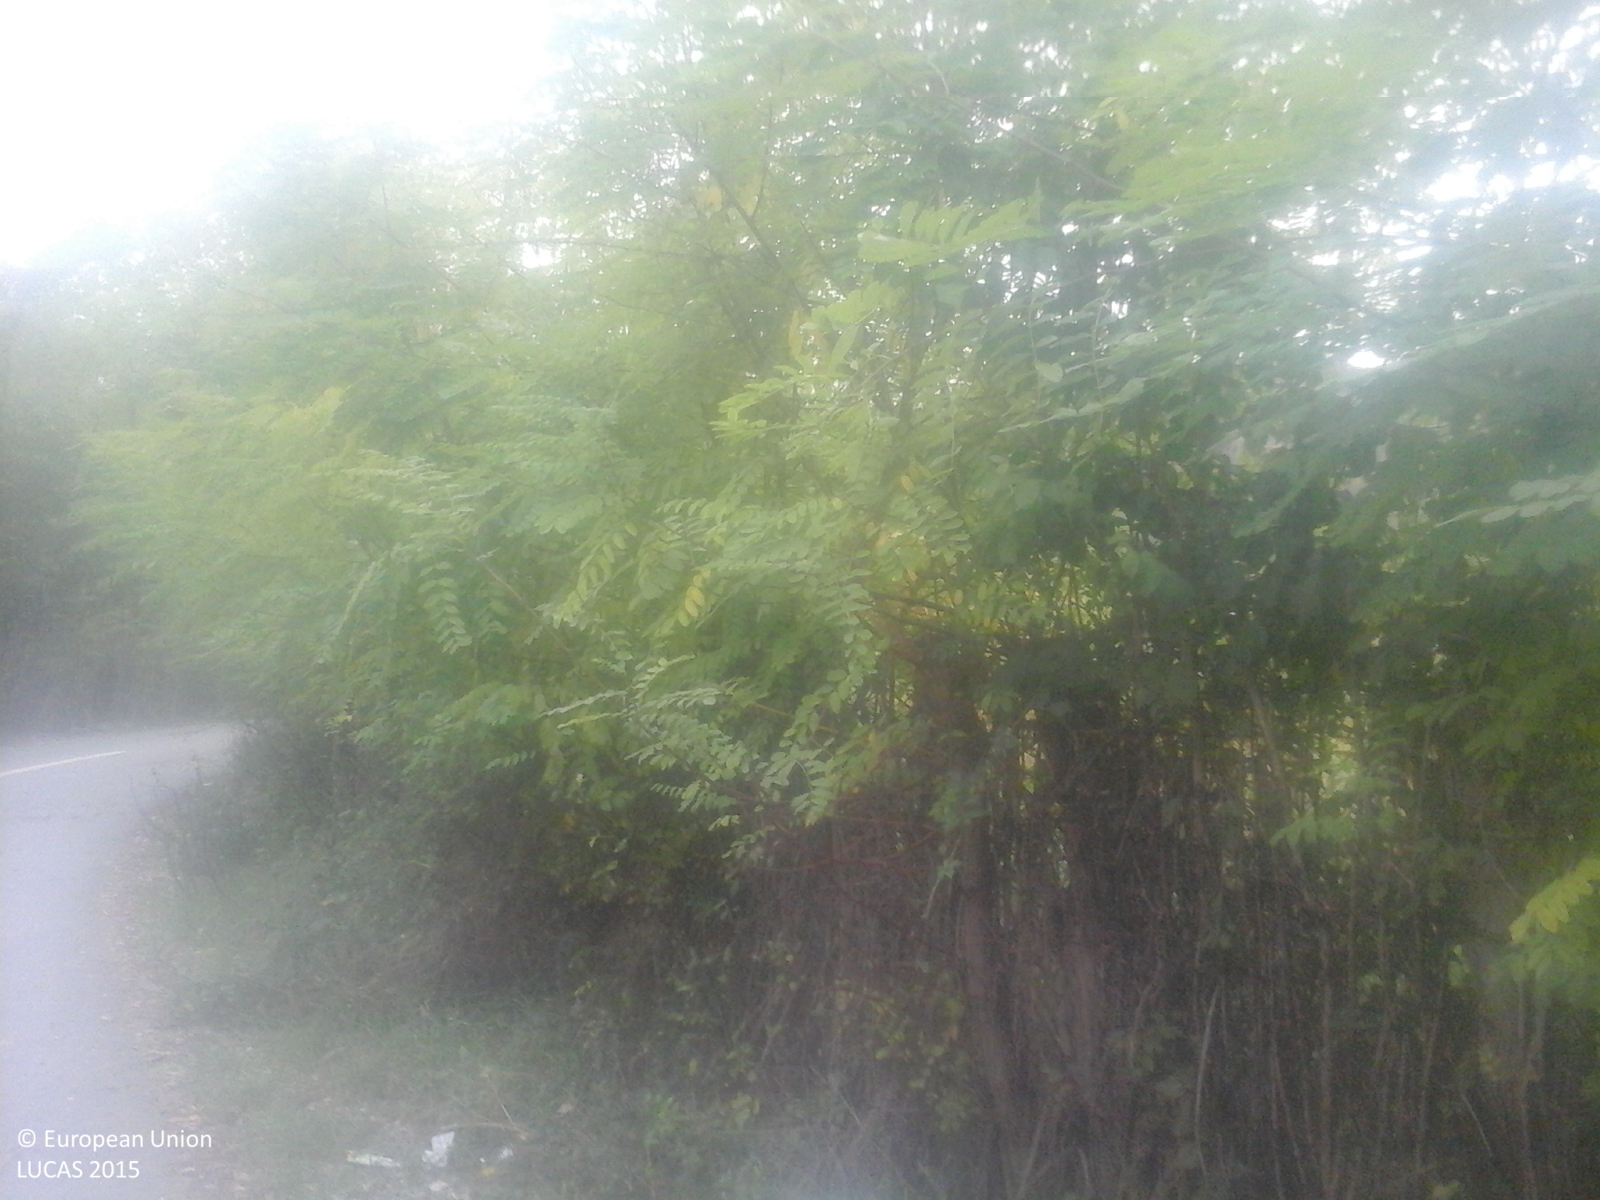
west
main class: Grassland
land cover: Spontaneously vegetated surfaces
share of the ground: > 75 %
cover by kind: herbaceous plants 100 %
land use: Agriculture (excluding fallow land and kitchen gardens)
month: October
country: RO
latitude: 45.0632
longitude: 25.7620
